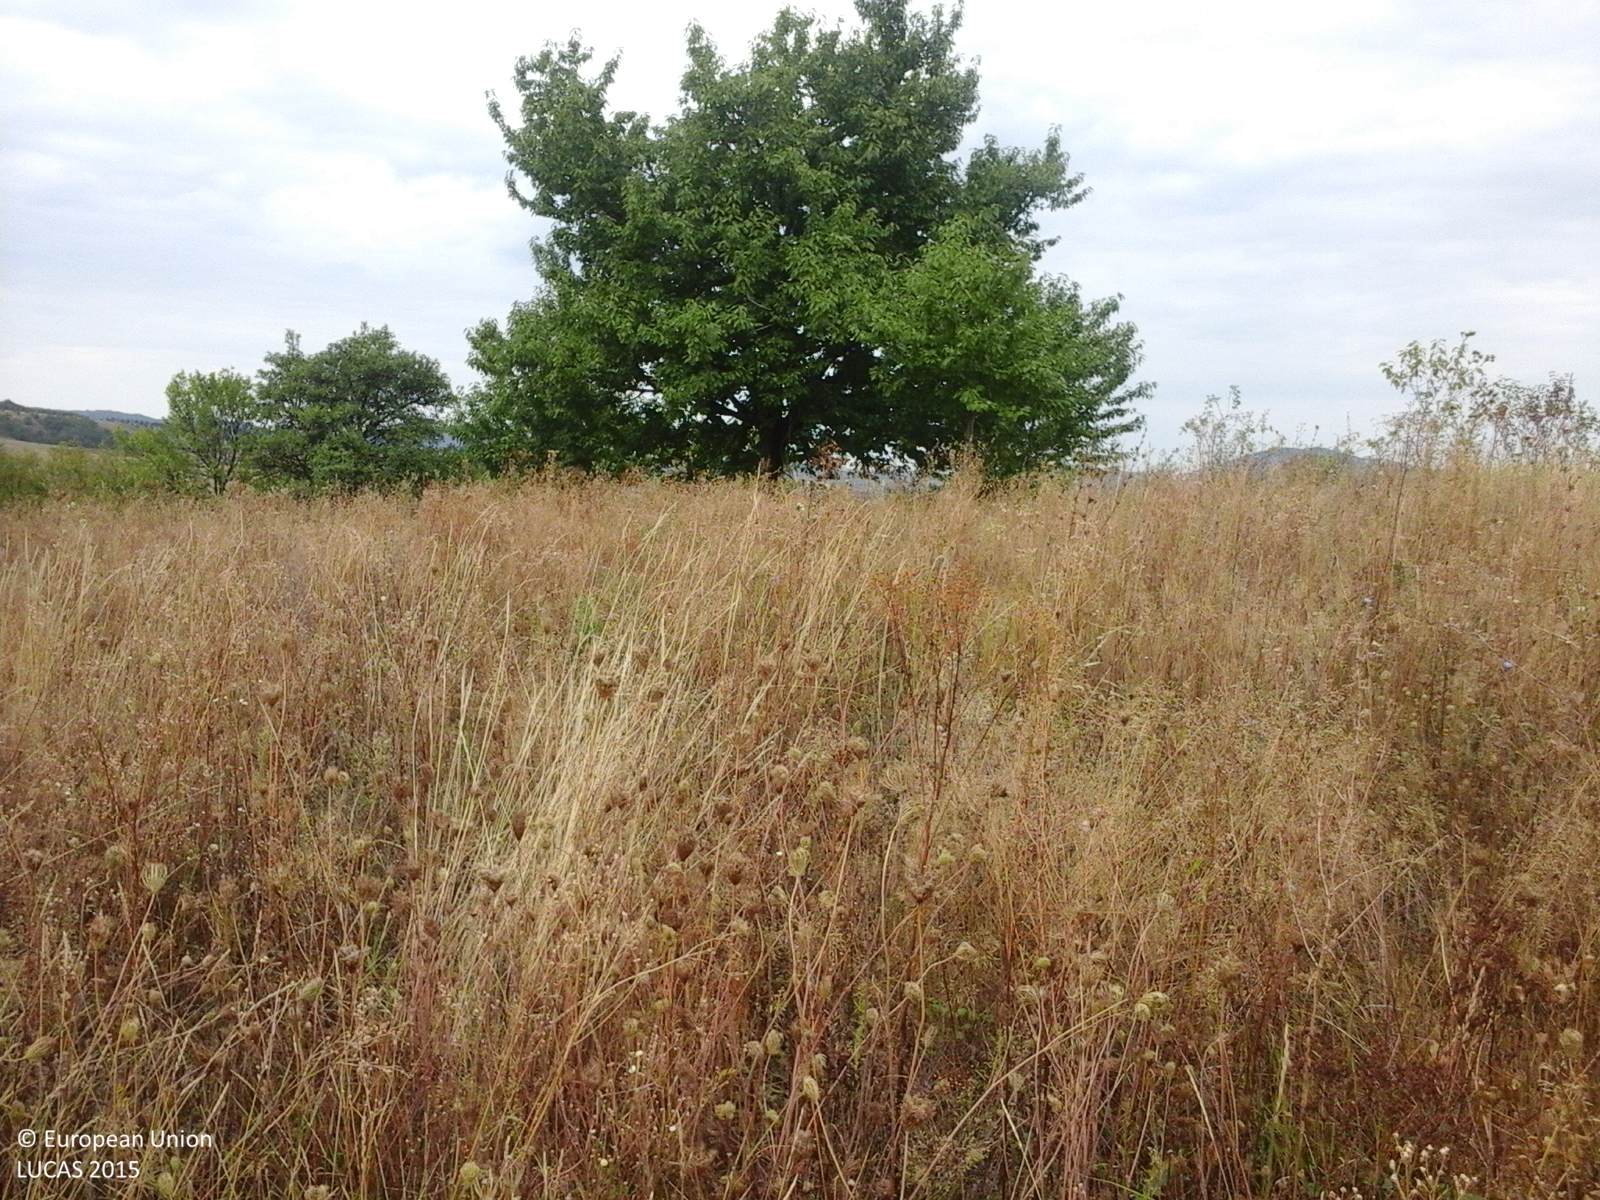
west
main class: Grassland
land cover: Spontaneously vegetated surfaces
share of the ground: > 75 %
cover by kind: herbaceous plants 100 %
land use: Fallow land
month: September
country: RO
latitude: 47.8216
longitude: 23.3903
